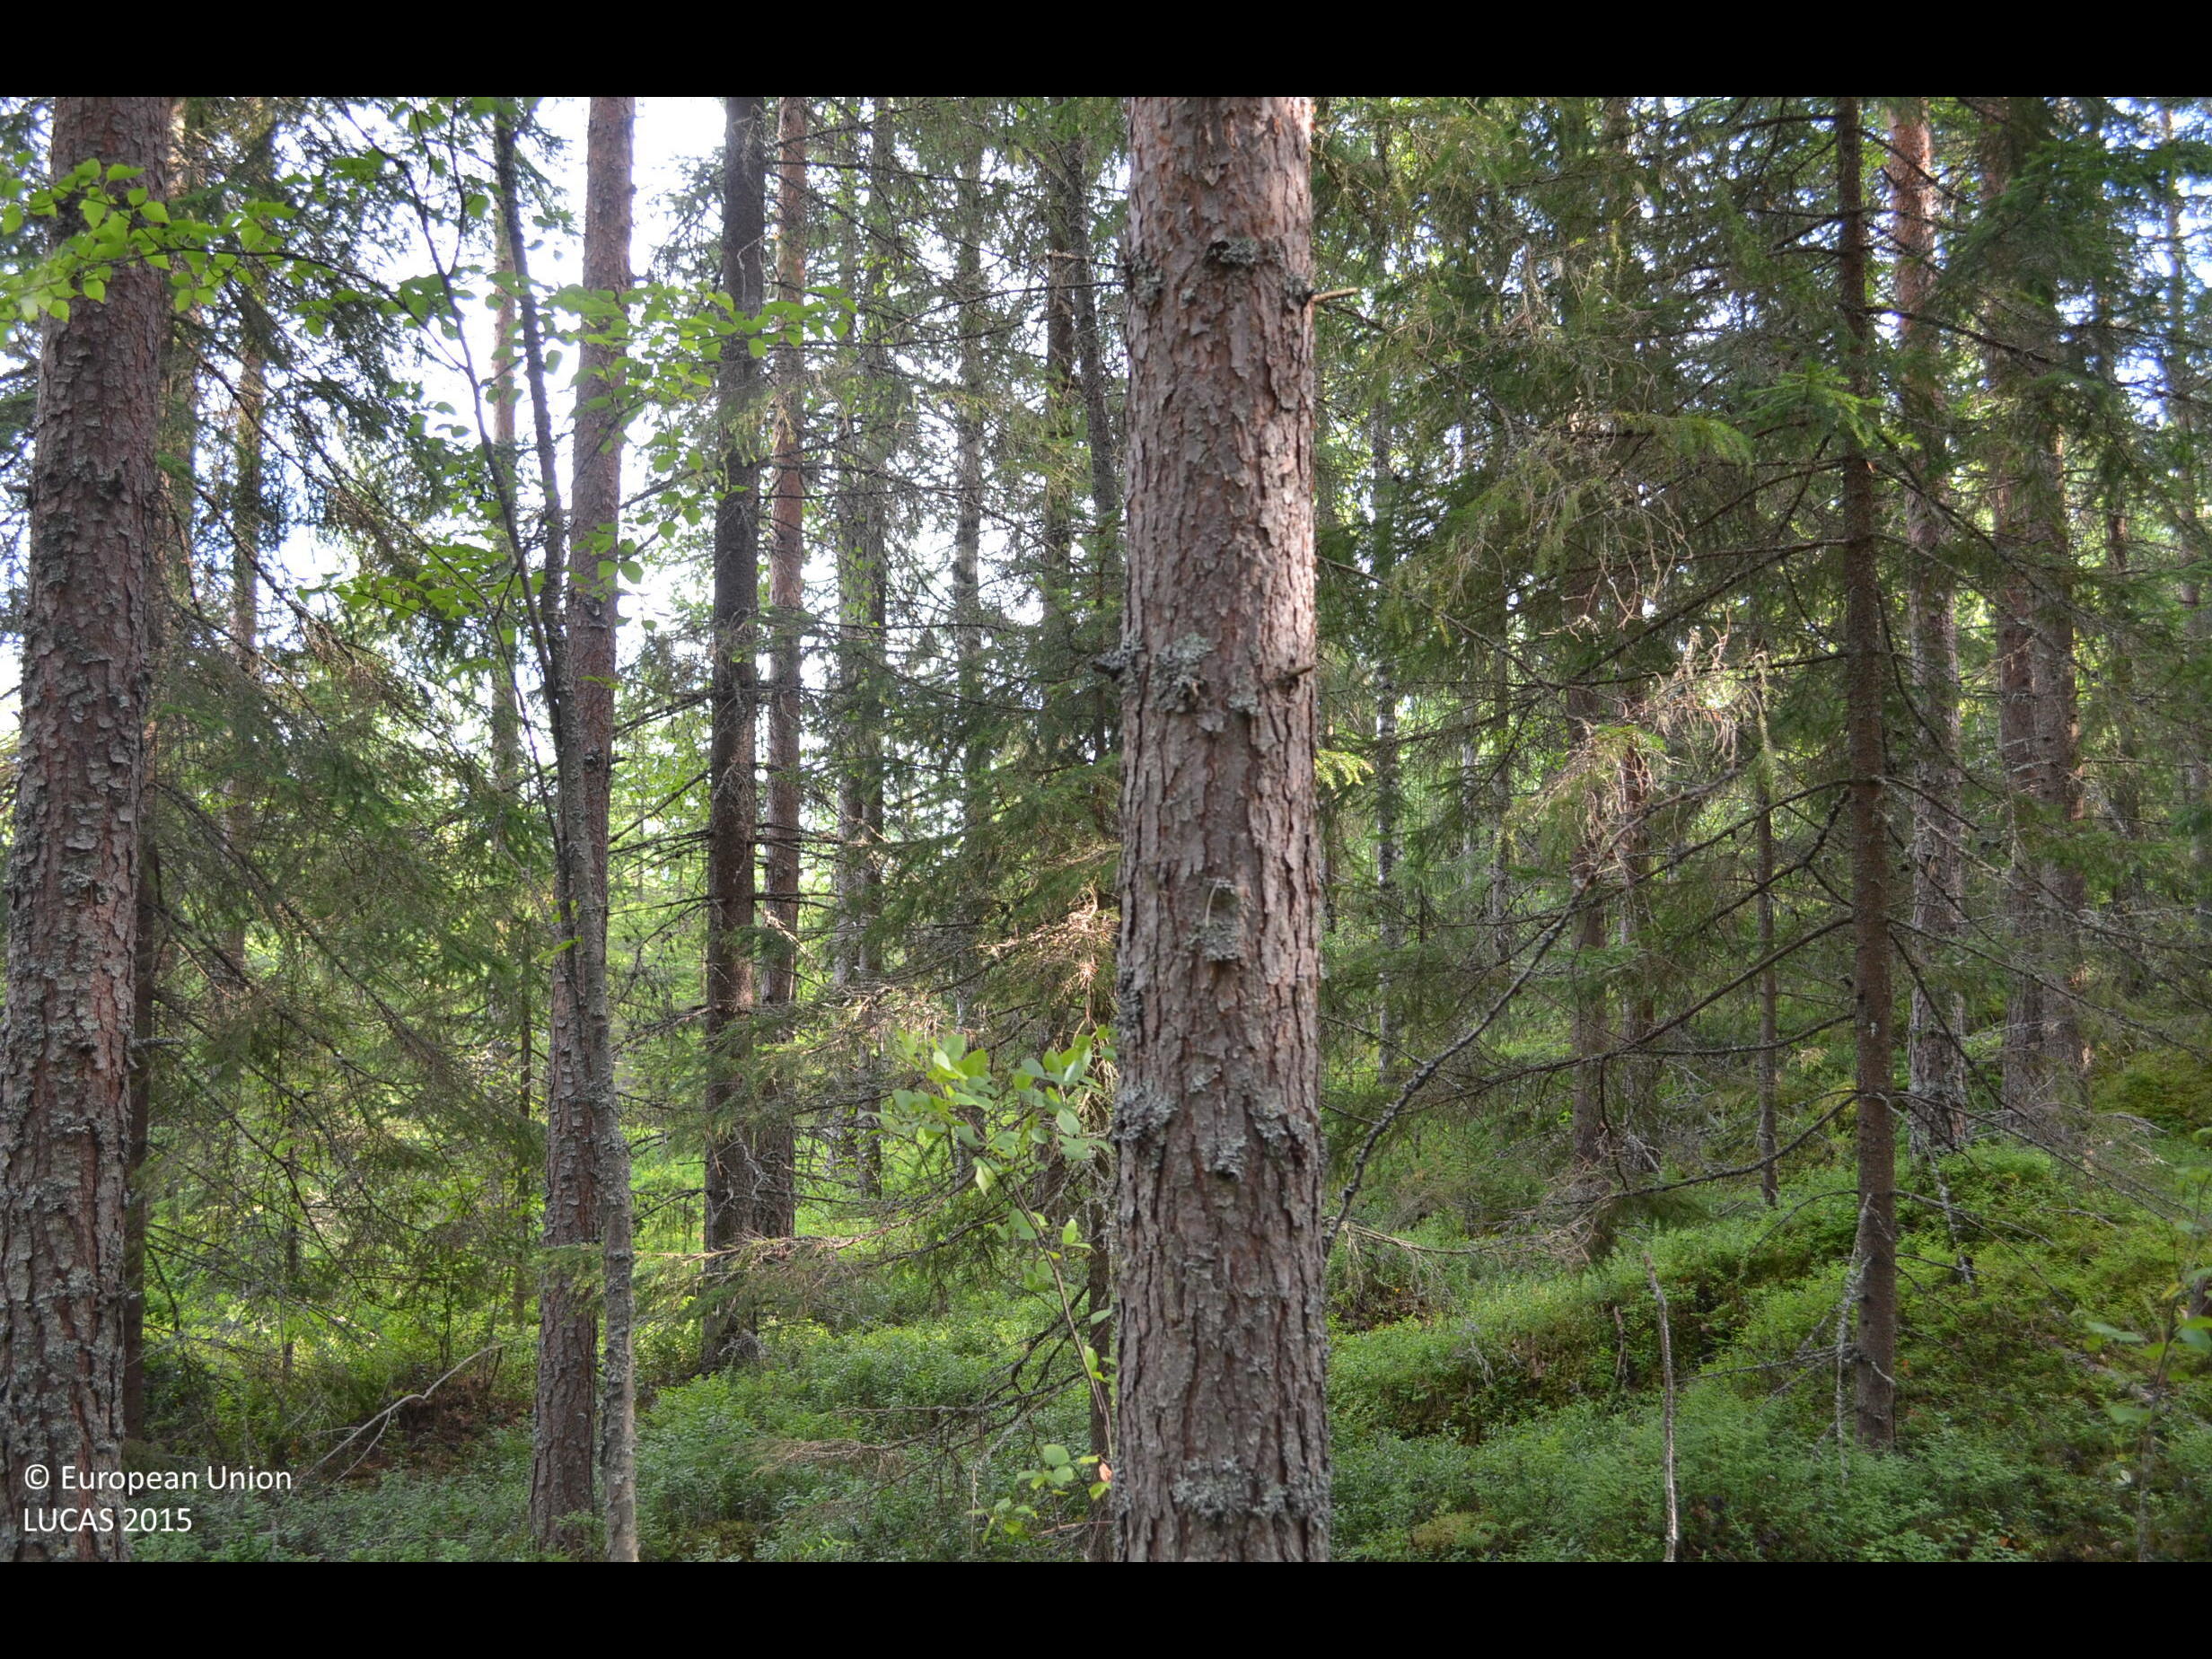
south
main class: Woodland
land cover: Other coniferous woodland
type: boreal forest
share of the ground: > 75 %
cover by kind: coniferous forest trees 70 %, shrubs 25 %, broadleaved forest trees 5 %
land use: Forestry
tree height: > 5 m
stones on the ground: < 10 %
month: July
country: FI
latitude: 61.9970
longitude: 24.3140
